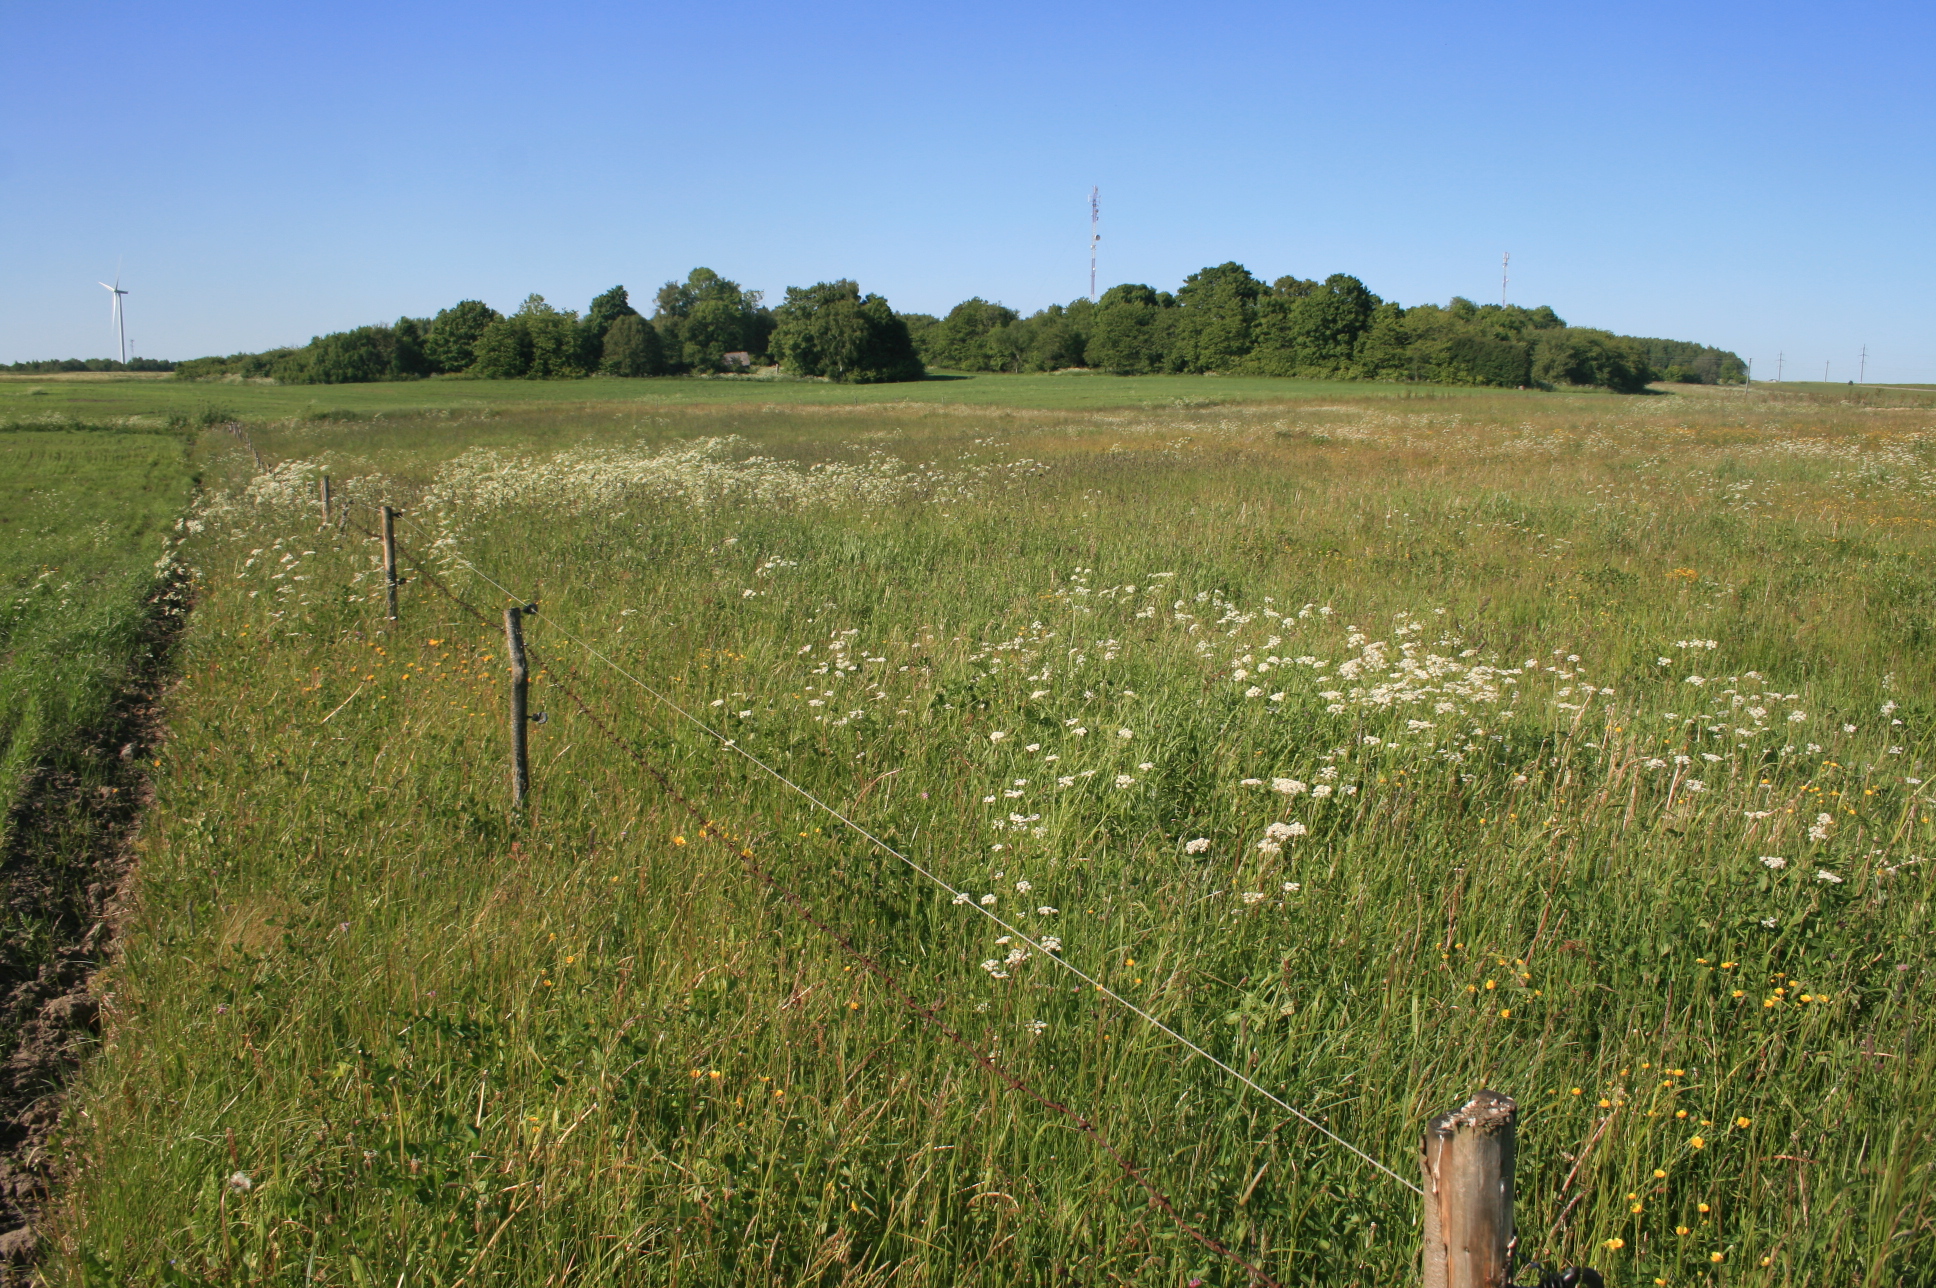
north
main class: Grassland
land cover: Grassland without tree/shrub cover
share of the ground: > 75 %
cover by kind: herbaceous plants 100 %
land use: Agriculture (excluding fallow land and kitchen gardens)
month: June
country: LT
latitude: 55.5471
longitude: 22.2129
